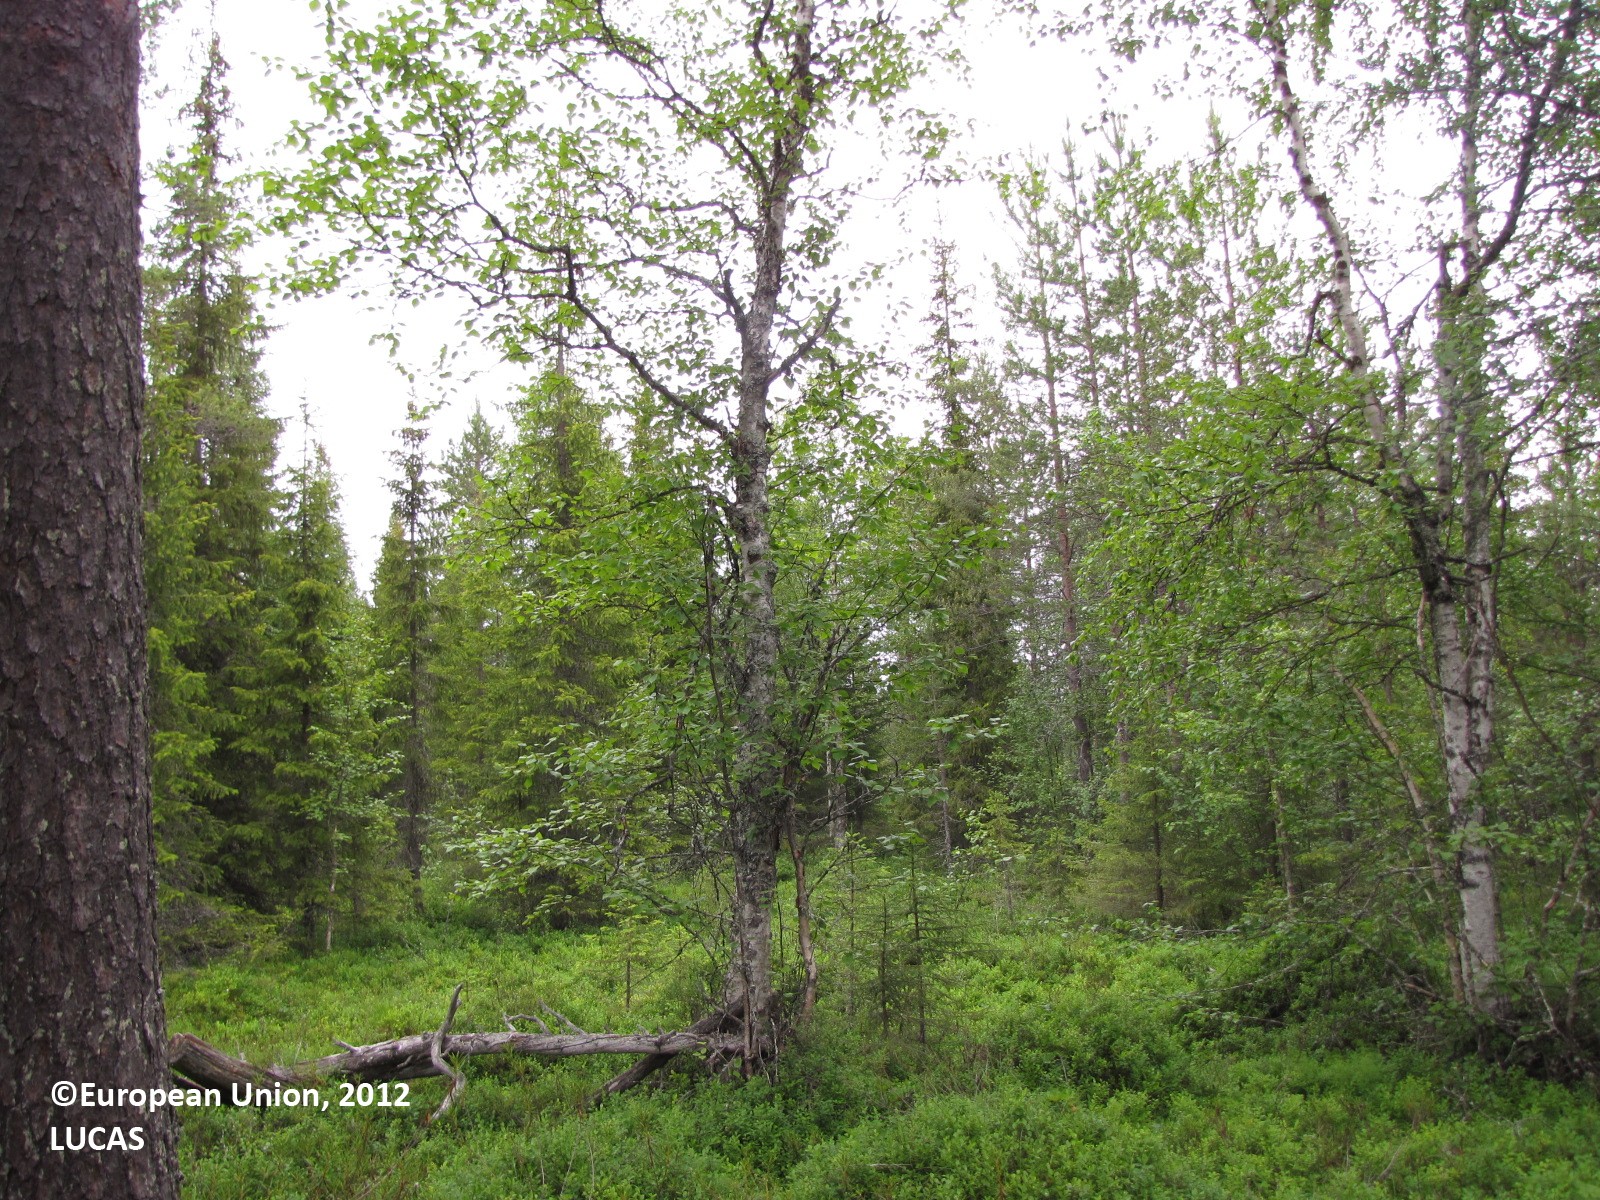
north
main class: Woodland
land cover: Spruce dominated mixed woodland
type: boreal forest
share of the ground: 25 - 50 %
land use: Forestry
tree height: > 5 m
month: July
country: FI
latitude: 66.5324
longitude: 24.9266
